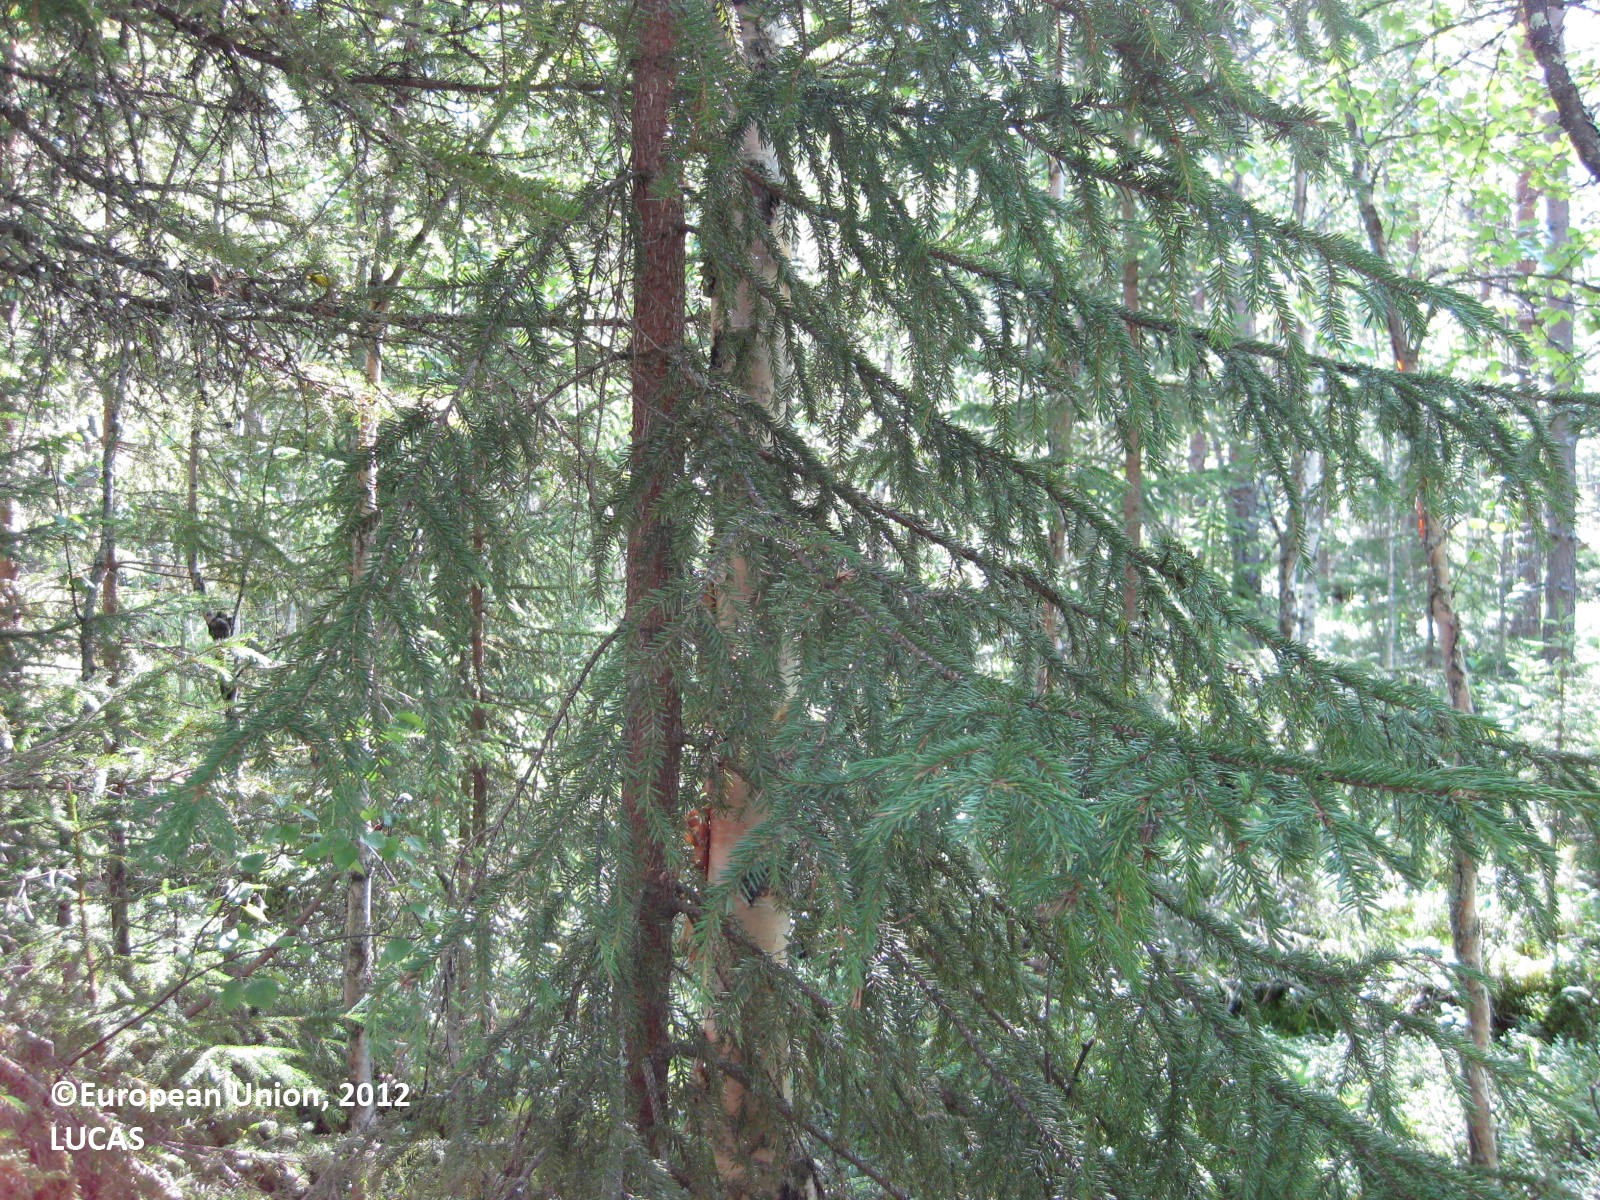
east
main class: Woodland
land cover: Pine dominated mixed woodland
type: boreal forest
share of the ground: 50 - 75 %
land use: Forestry
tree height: > 5 m
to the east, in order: Pine dominated mixed woodland; Ditches and canals; Pine dominated mixed woodland; Ditches and canals; Pine dominated mixed woodland; Ditches and canals; Pine dominated mixed woodland; Ditches and canals; Pine dominated mixed woodland; Ditches and canals; Pine dominated mixed woodland; Ditches and canals; Pine dominated mixed woodland; Ditches and canals; Pine dominated mixed woodland; Ditches and canals; Pine dominated mixed woodland; Ditches and canals; Pine dominated mixed woodland; Ditches and canals; Pine dominated mixed woodland; Ditches and canals; Pine dominated mixed woodland; Ditches and canals; Pine dominated mixed woodland; Ditches and canals; Pine dominated mixed woodland; Ditches and canals; Pine dominated mixed woodland; Ditches and canals; Pine dominated mixed woodland; Ditches and canals; Pine dominated mixed woodland; Ditches and canals; Pine dominated mixed woodland; Ditches and canals; Tracks; Abandoned hedges; Tracks; Other mixed woodland; Ditches and canals; Other mixed woodland; Ditches and canals; Other mixed woodland; Ditches and canals; Other mixed woodland; Ditches and canals; Tracks; Abandoned hedges; Tracks; Other mixed woodland
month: July
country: FI
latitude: 65.5775
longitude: 28.4753
